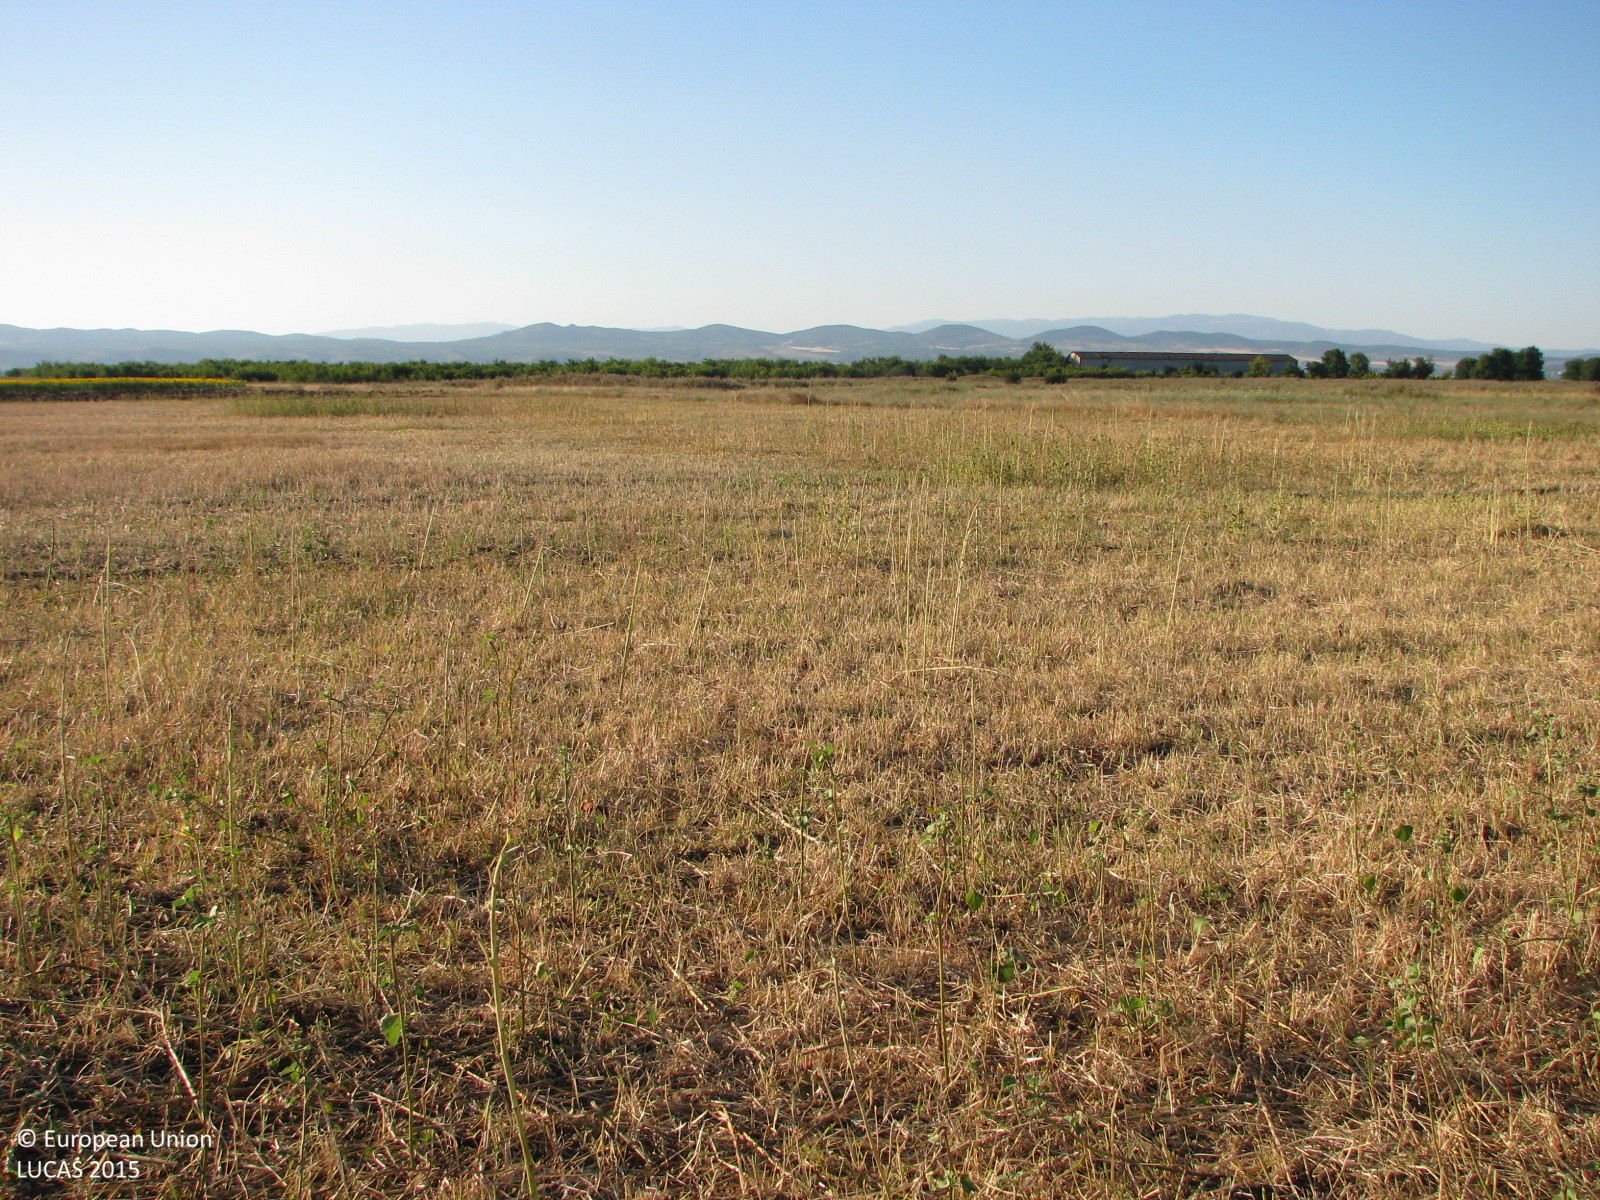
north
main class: Cropland
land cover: Common wheat
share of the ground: 10 - 25 %
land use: Agriculture (excluding fallow land and kitchen gardens)
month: July
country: BG
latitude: 42.4607
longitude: 25.9741
